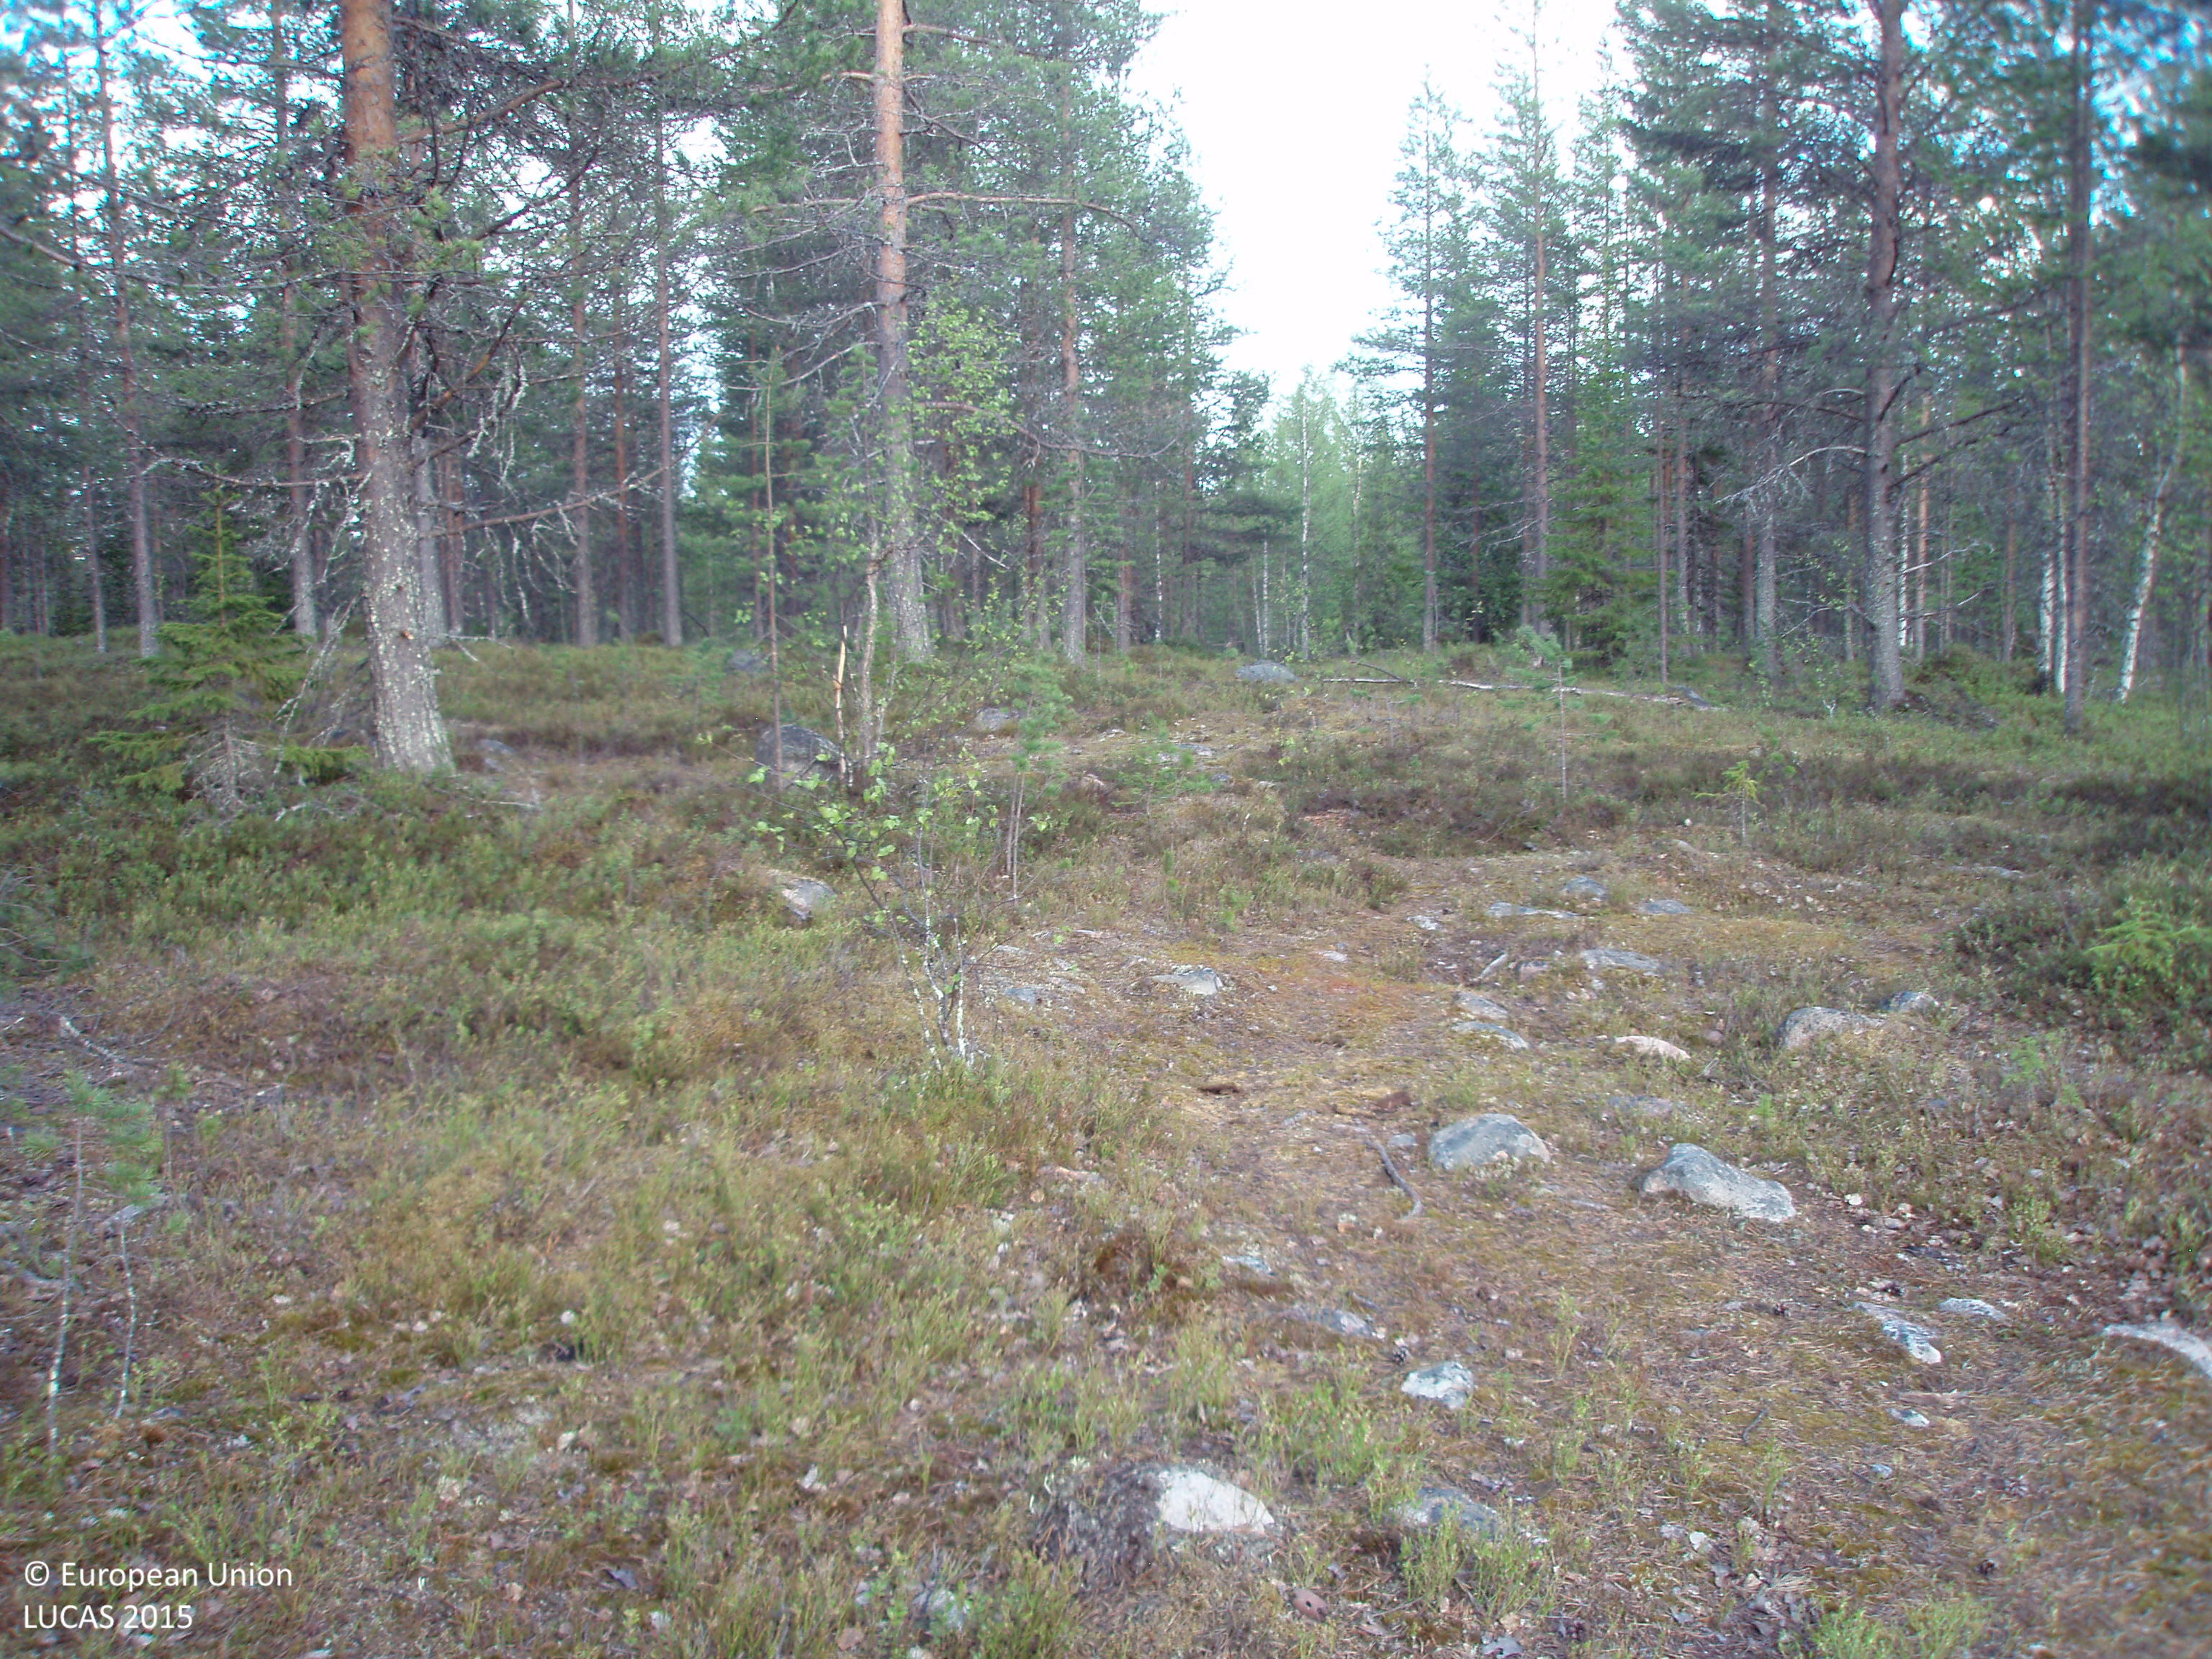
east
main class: Woodland
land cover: Pine dominated coniferous woodland
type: boreal forest
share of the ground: 50 - 75 %
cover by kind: coniferous forest trees 65 %, shrubs 20 %, broadleaved forest trees 5 %, lichens and mosses 5 %, unconsolidated bare surface 5 %
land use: Forestry
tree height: > 5 m
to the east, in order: Pine dominated coniferous woodland; Tracks; Pine dominated coniferous woodland; Tracks; Pine dominated mixed woodland
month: June
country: FI
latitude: 66.6787
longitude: 26.5419
